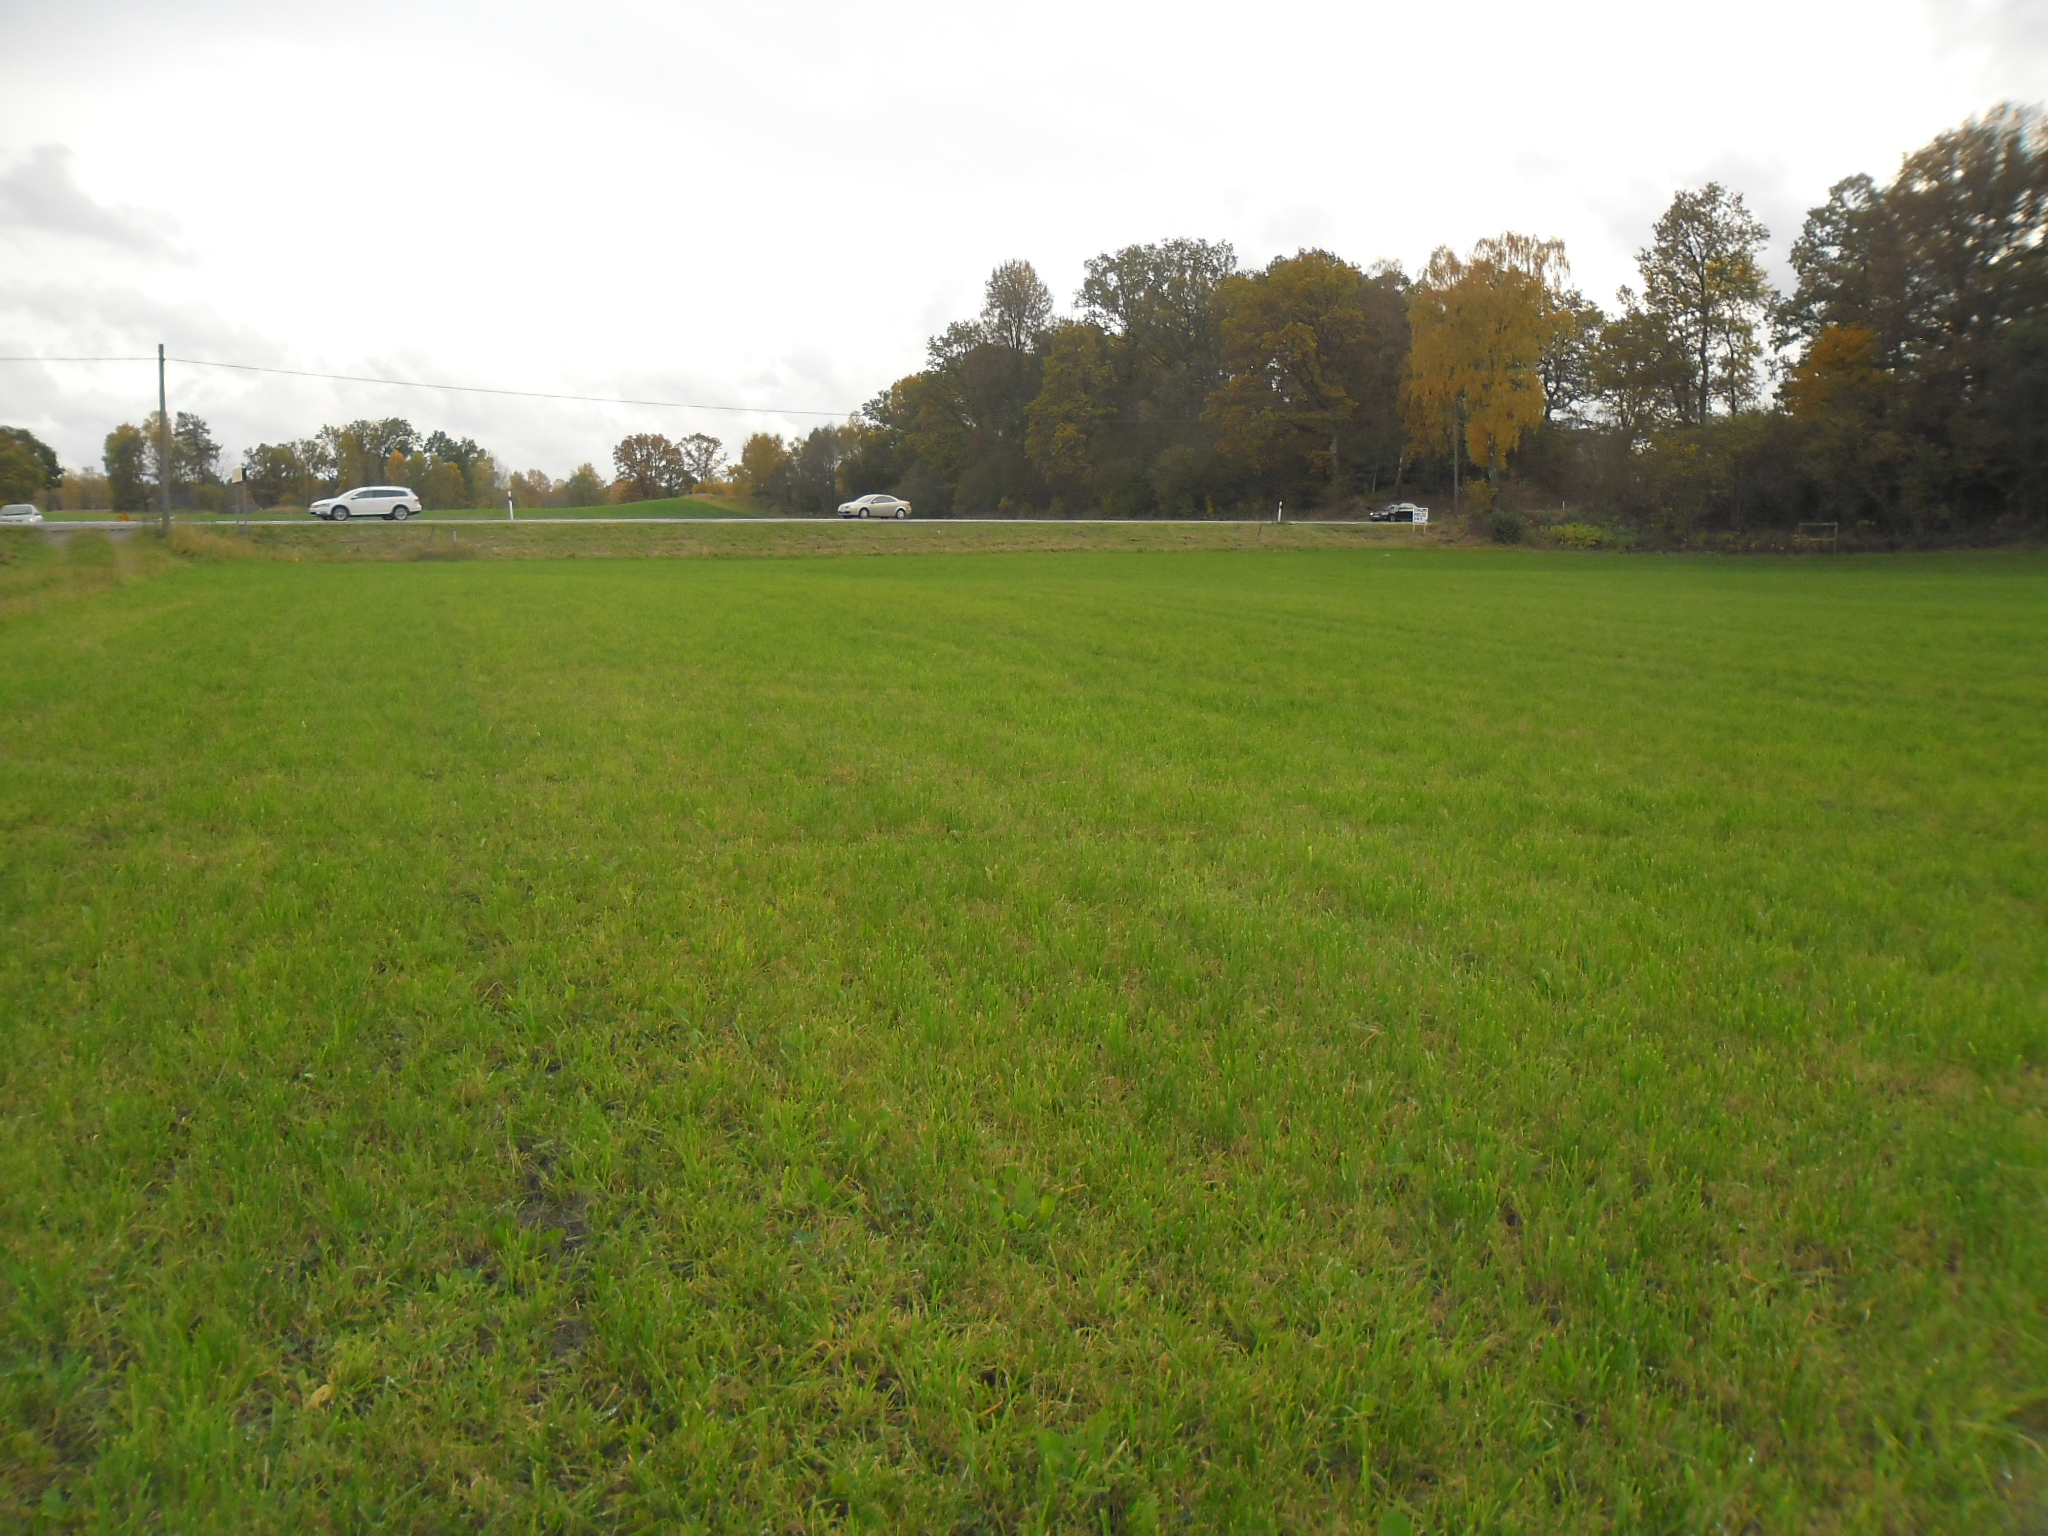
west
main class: Grassland
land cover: Grassland without tree/shrub cover
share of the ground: > 75 %
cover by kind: herbaceous plants 100 %
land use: Agriculture (excluding fallow land and kitchen gardens)
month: October
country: SE
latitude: 56.0443
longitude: 13.7059
